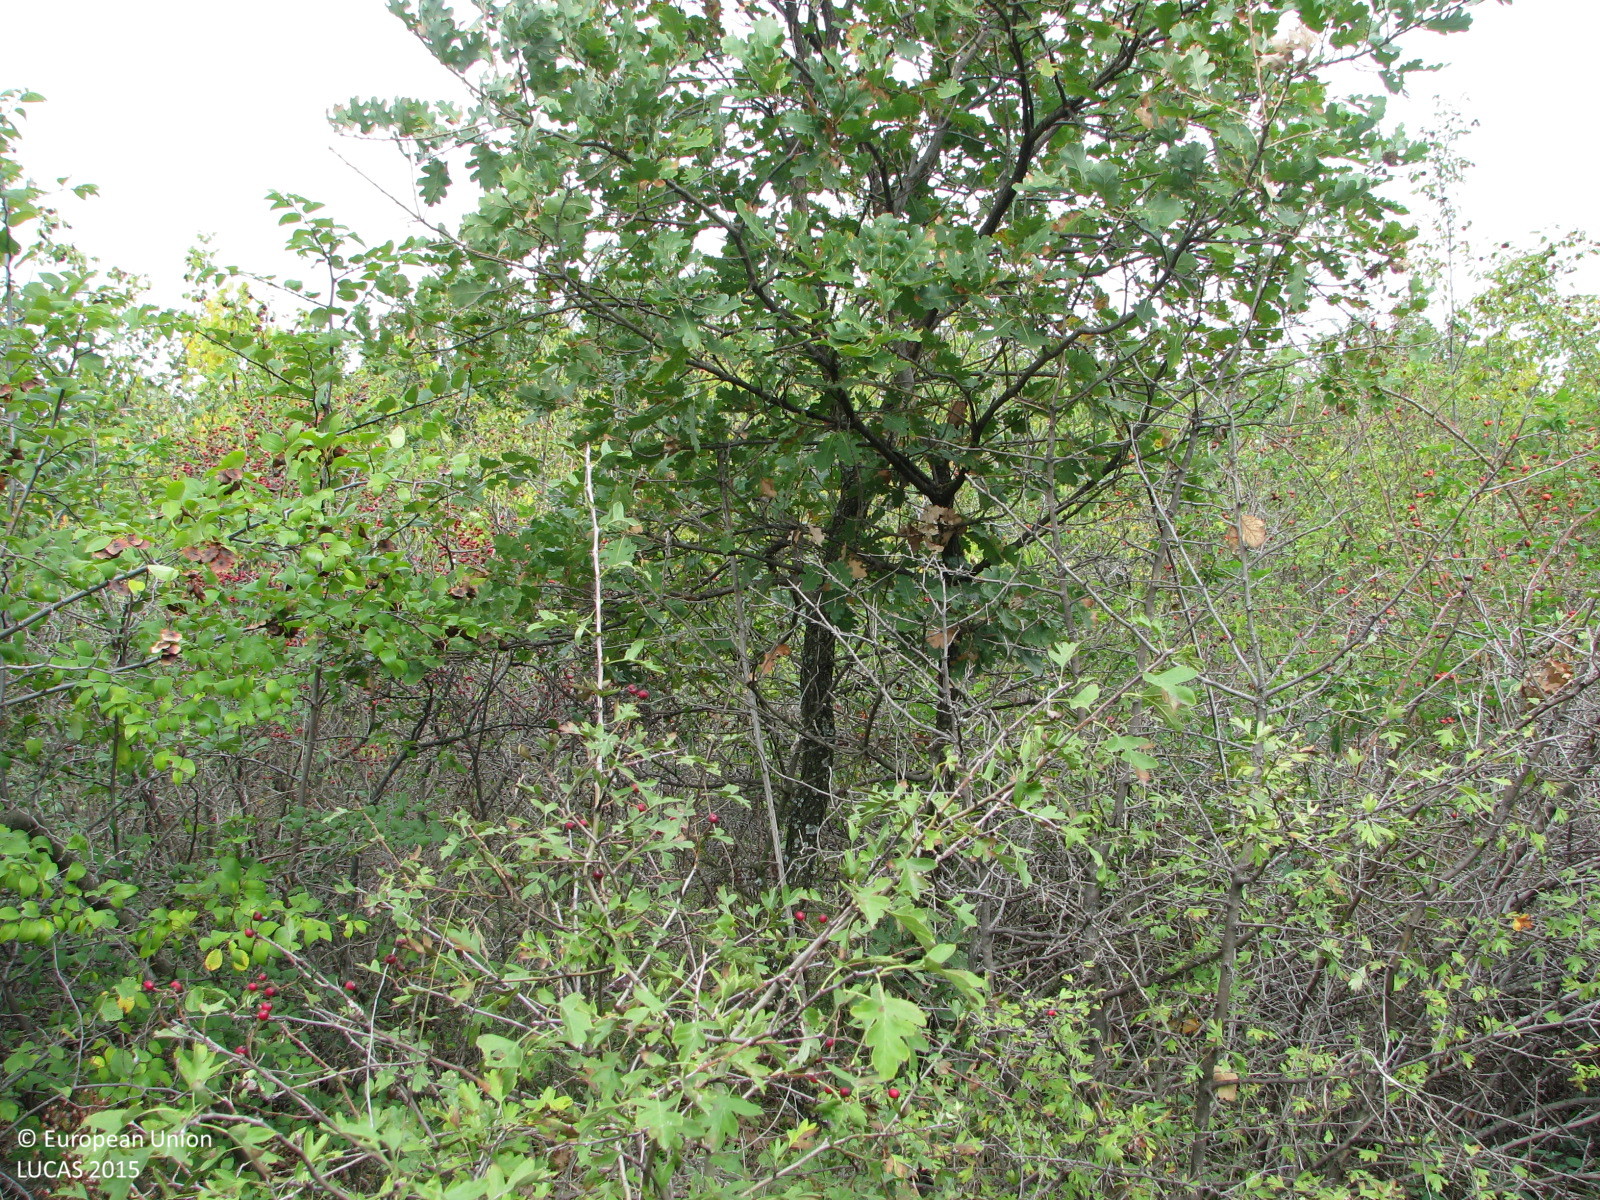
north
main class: Shrubland
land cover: Shrubland with sparse tree cover
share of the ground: > 75 %
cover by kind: shrubs 90 %, broadleaved forest trees 5 %, herbaceous plants 5 %
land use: Semi-natural and natural areas not in use
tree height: < 5 m
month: October
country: BG
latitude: 42.4124
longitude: 26.1598
